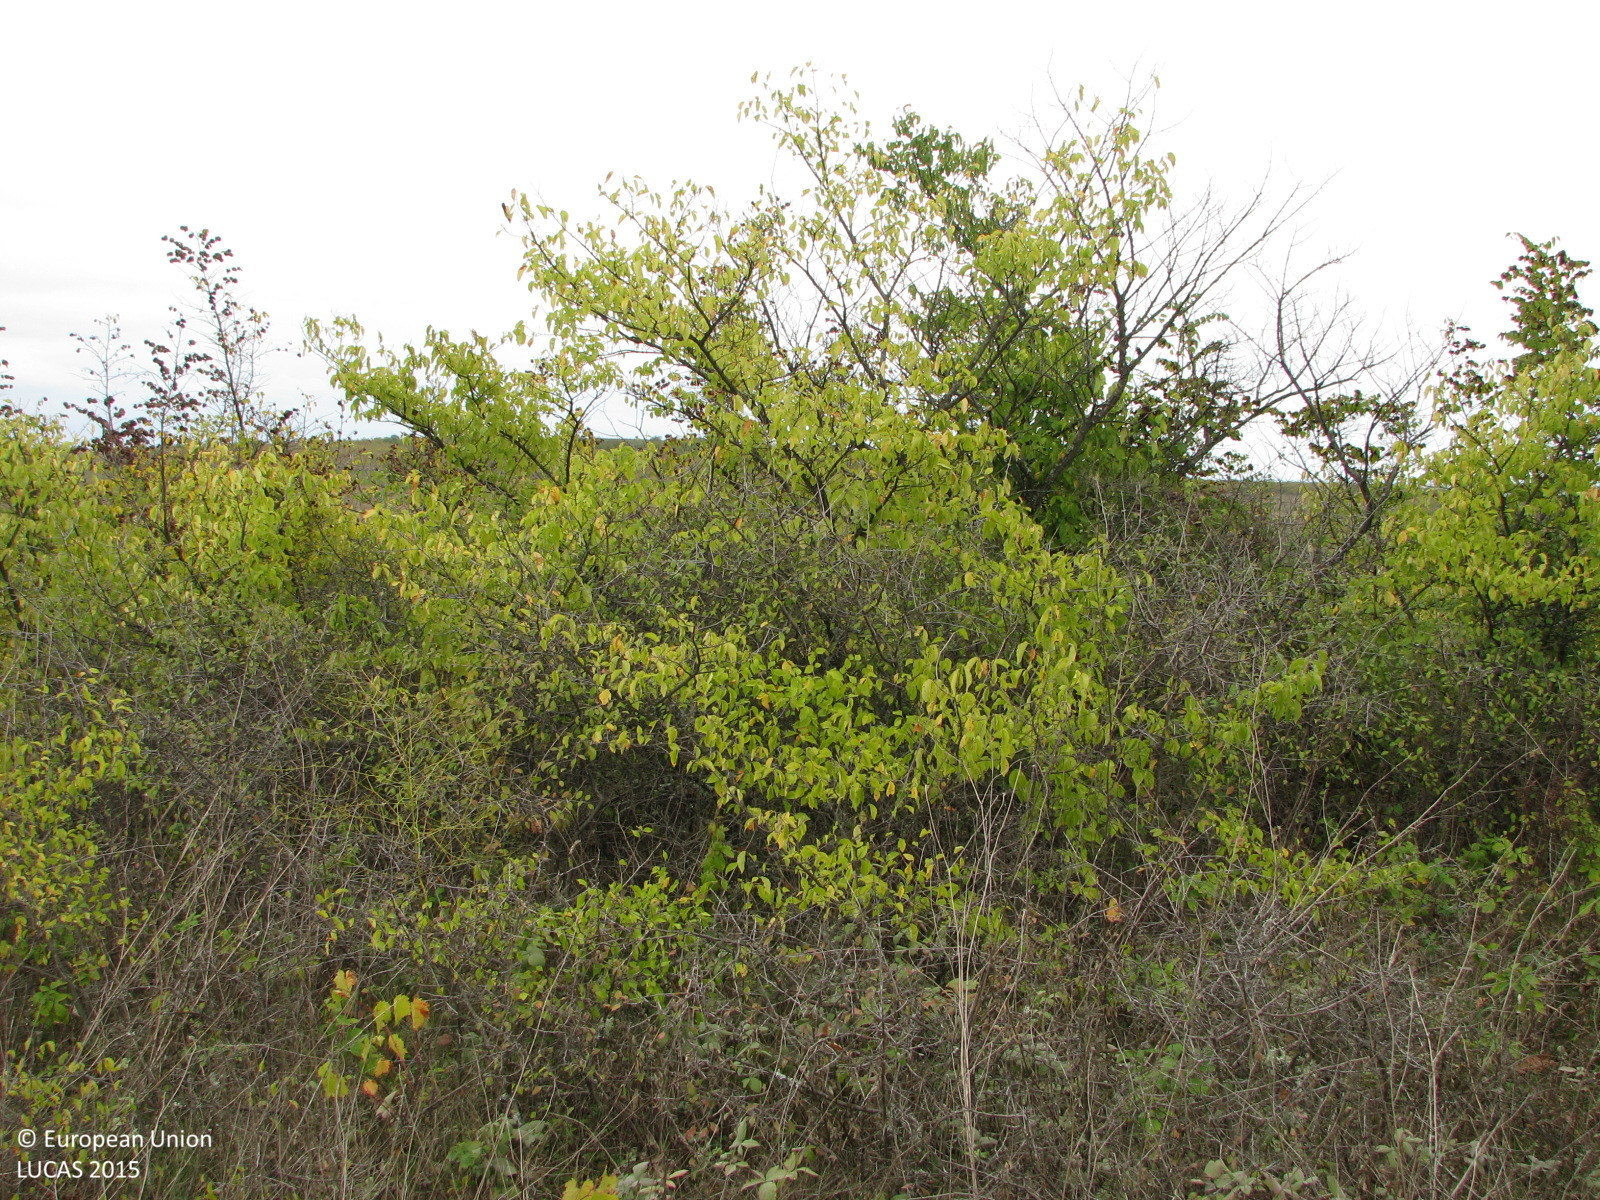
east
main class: Shrubland
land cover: Shrubland with sparse tree cover
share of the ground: 50 - 75 %
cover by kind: shrubs 60 %, herbaceous plants 35 %, broadleaved forest trees 5 %
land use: Semi-natural and natural areas not in use
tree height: < 5 m
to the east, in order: Shrubland with sparse tree cover; Grassland with sparse tree/shrub cover; Shrubland with sparse tree cover; Other bare soil; Grassland without tree/shrub cover; Tracks; Grass margins; Other bare soil
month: October
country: BG
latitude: 42.1371
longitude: 26.3819
